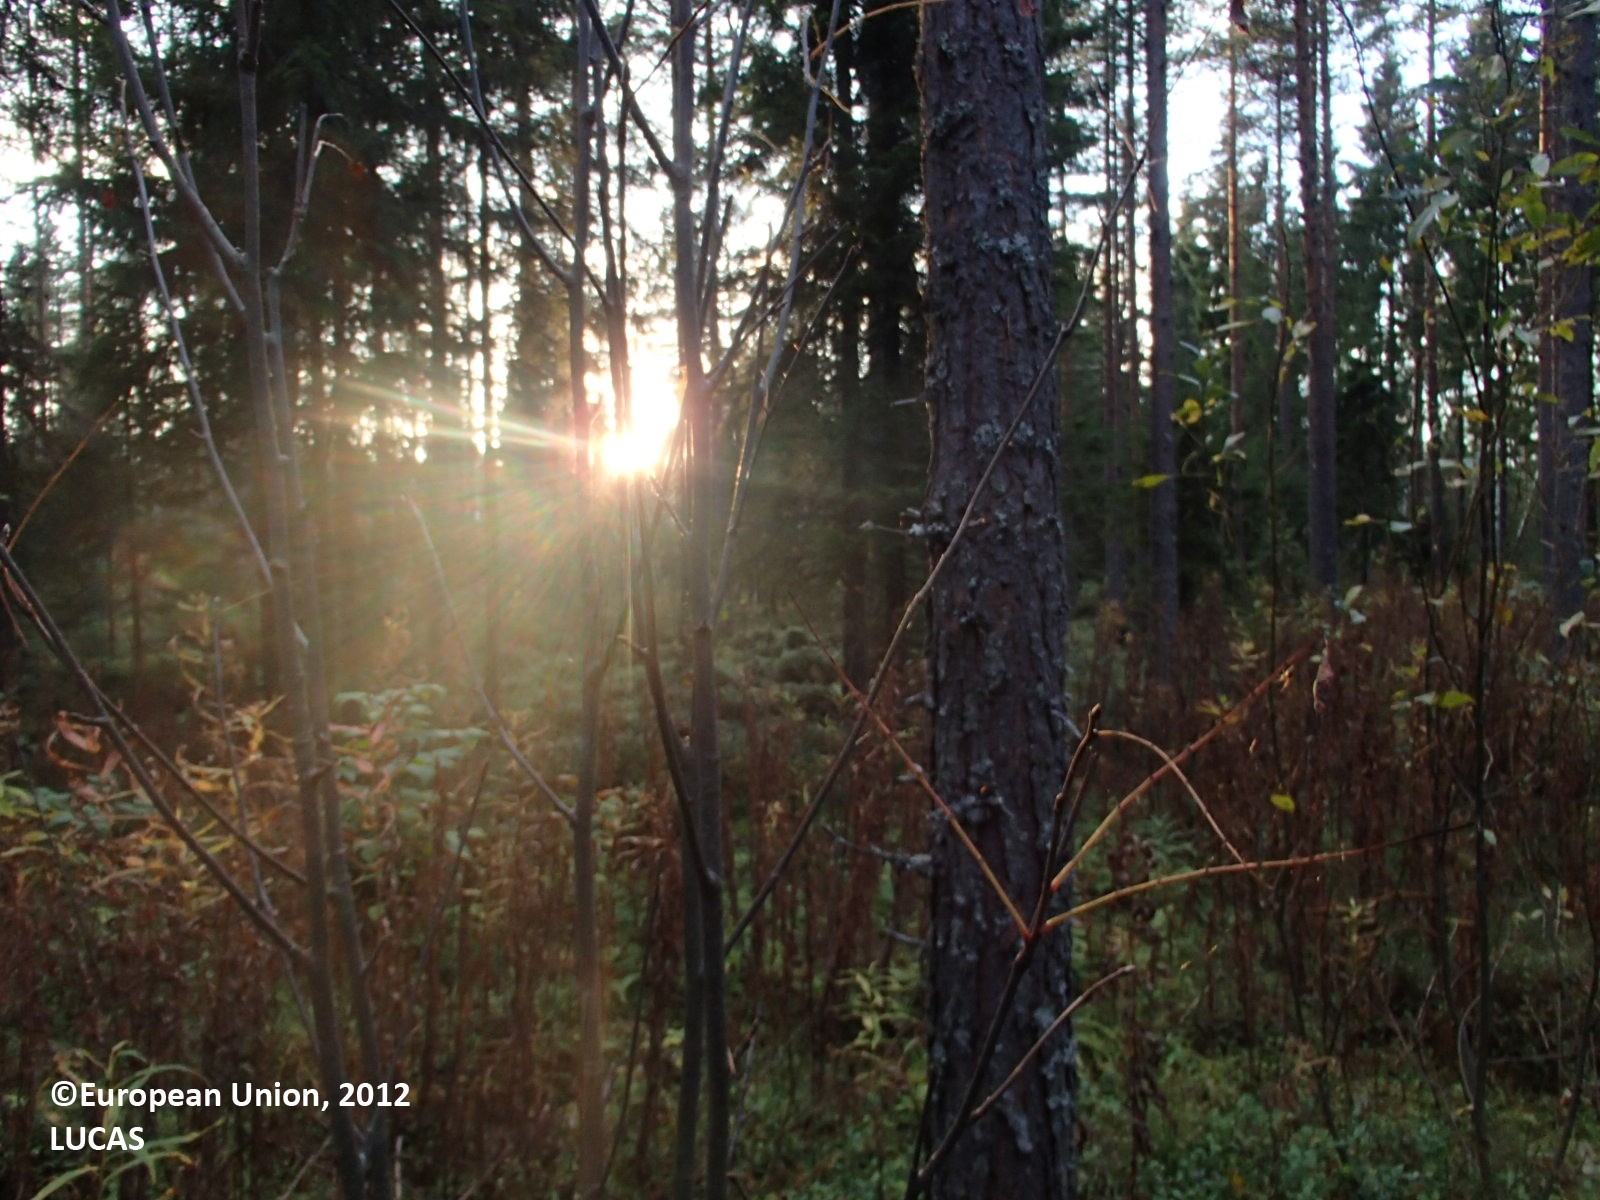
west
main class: Woodland
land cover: Spruce dominated coniferous woodland
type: boreal forest
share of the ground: > 75 %
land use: Forestry
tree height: > 5 m
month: September
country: FI
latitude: 63.5521
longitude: 26.0735
